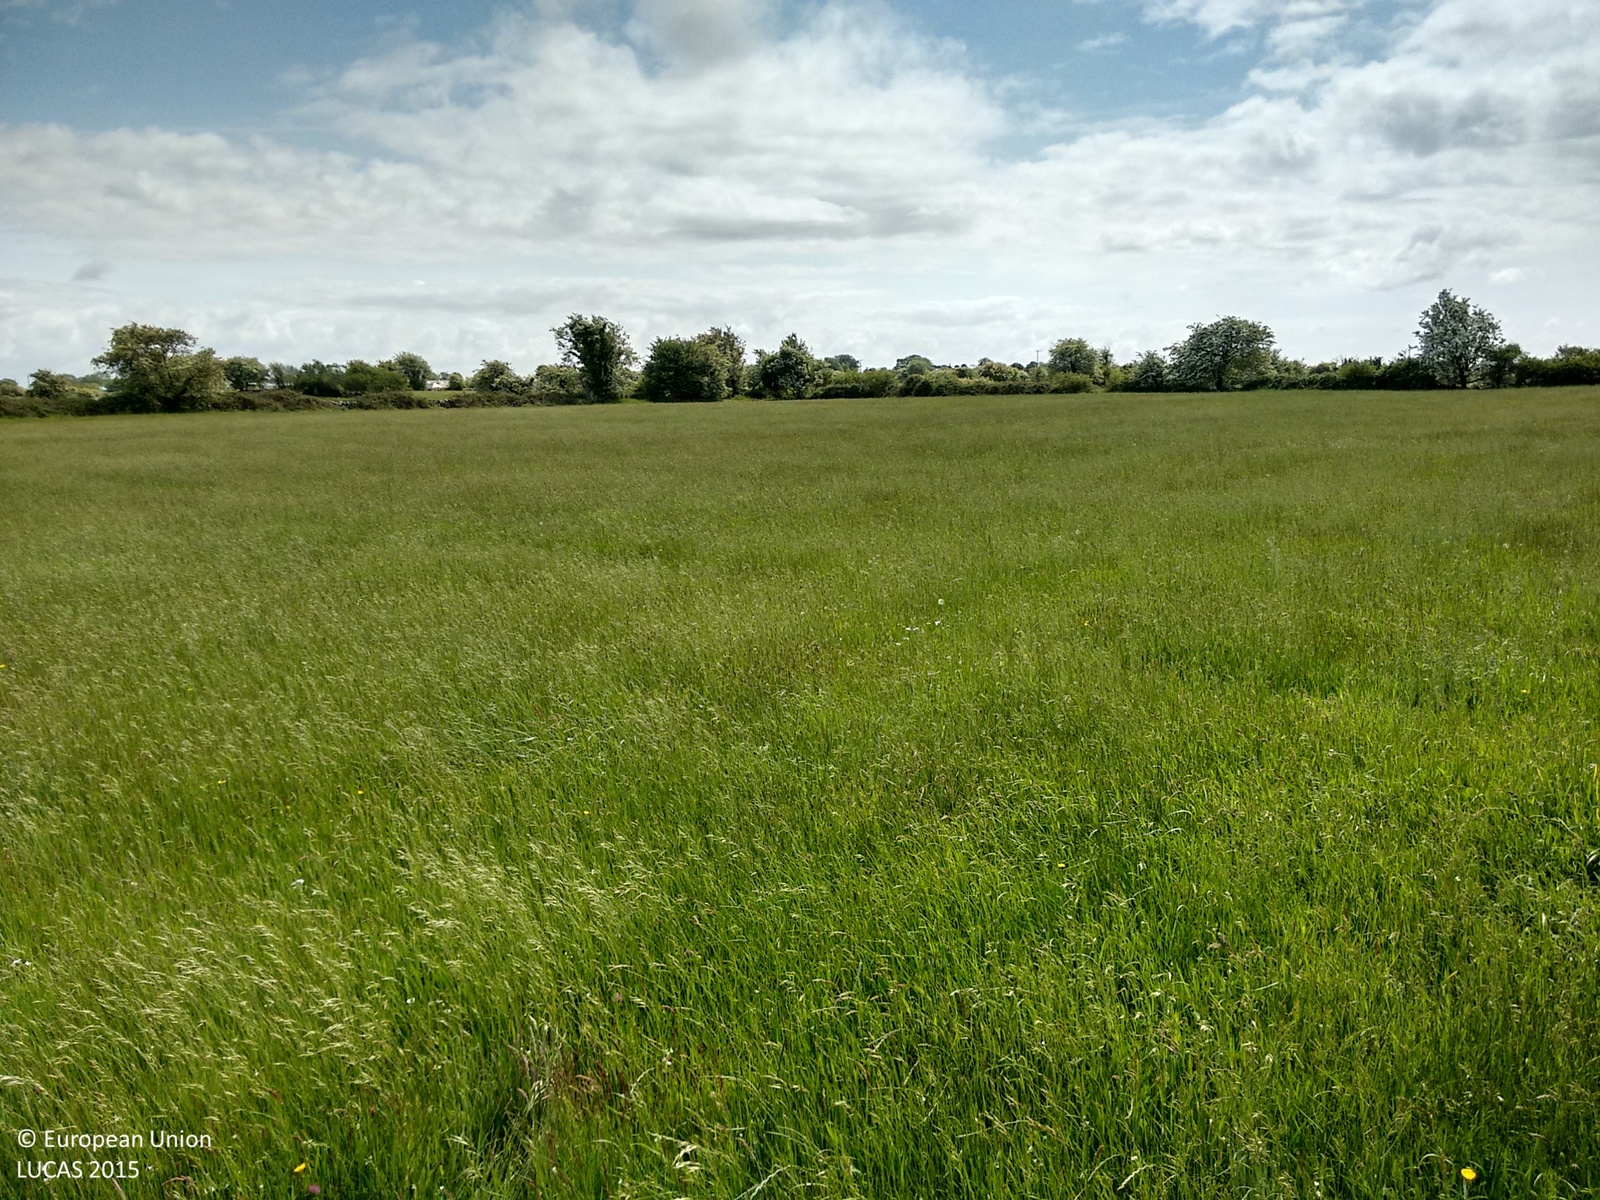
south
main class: Grassland
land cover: Grassland without tree/shrub cover
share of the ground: > 75 %
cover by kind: herbaceous plants 100 %
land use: Agriculture (excluding fallow land and kitchen gardens)
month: June
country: IE
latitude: 53.4515
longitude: -8.9897
